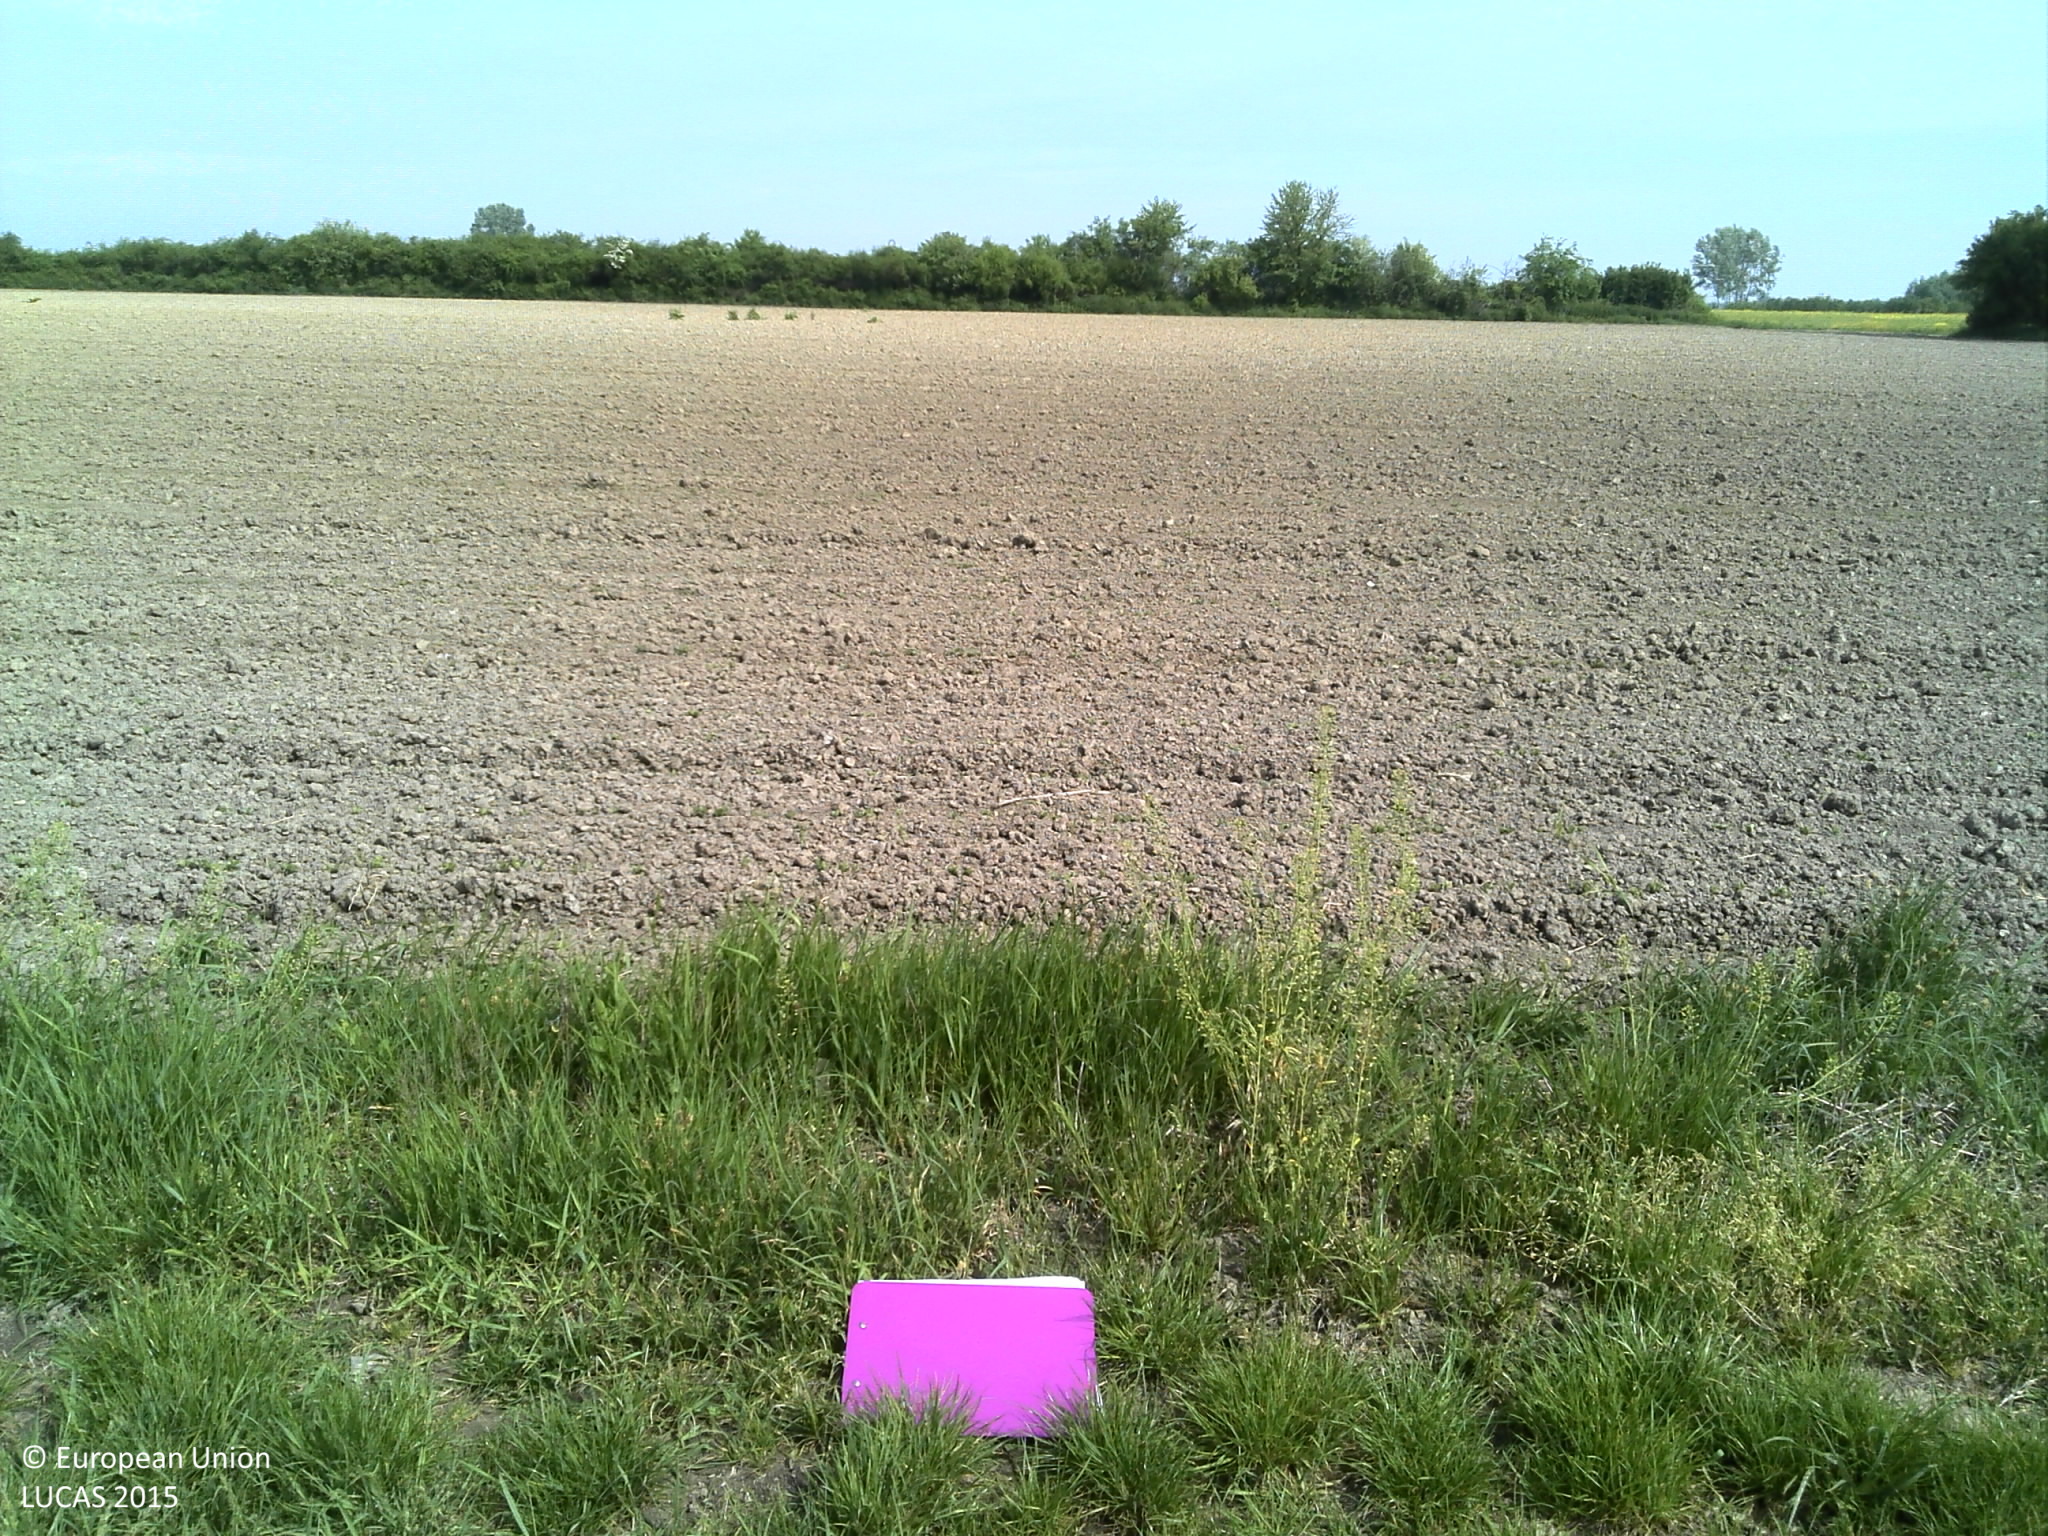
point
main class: Cropland
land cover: Soya
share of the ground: < 10 %
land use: Agriculture (excluding fallow land and kitchen gardens)
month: April
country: HR
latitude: 44.9610
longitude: 18.9440
